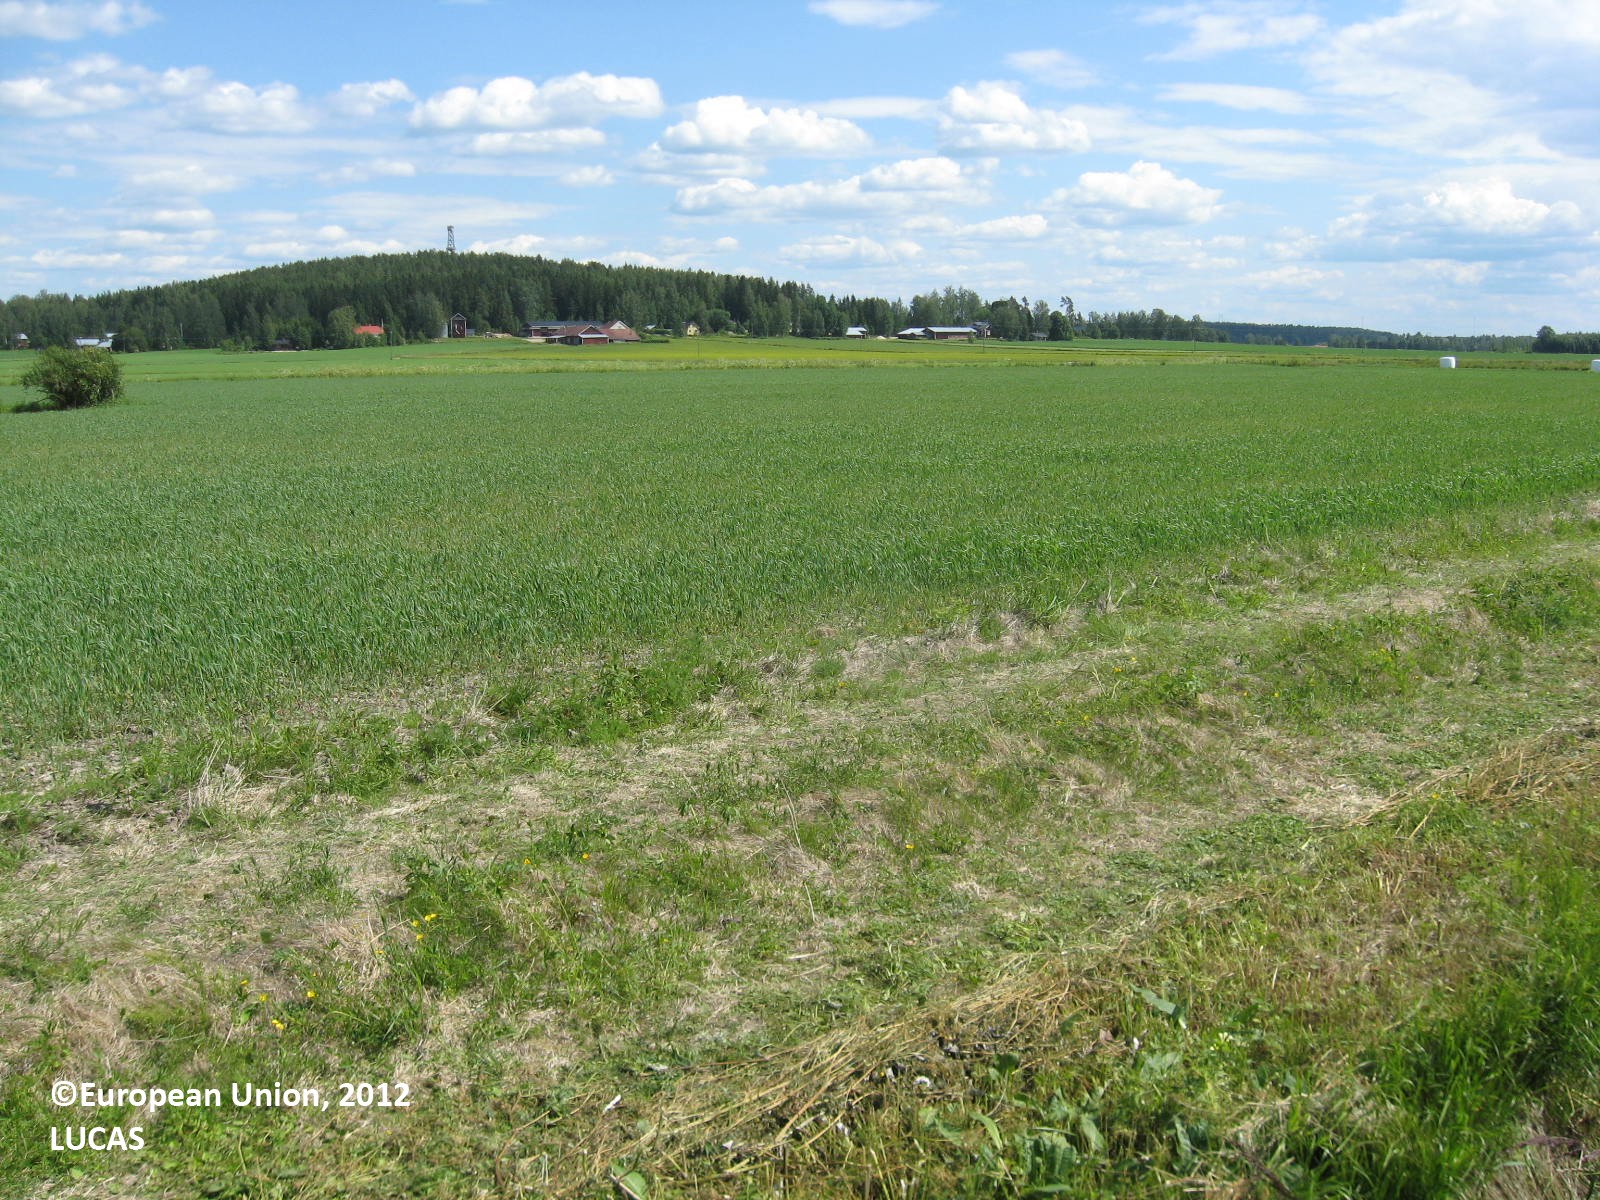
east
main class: Cropland
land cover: Oats
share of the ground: > 75 %
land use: Agriculture (excluding fallow land and kitchen gardens)
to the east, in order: Oats; Shruby margins; Ditches and canals; Shruby margins; Barley
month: July
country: FI
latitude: 62.6013
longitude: 22.5018
